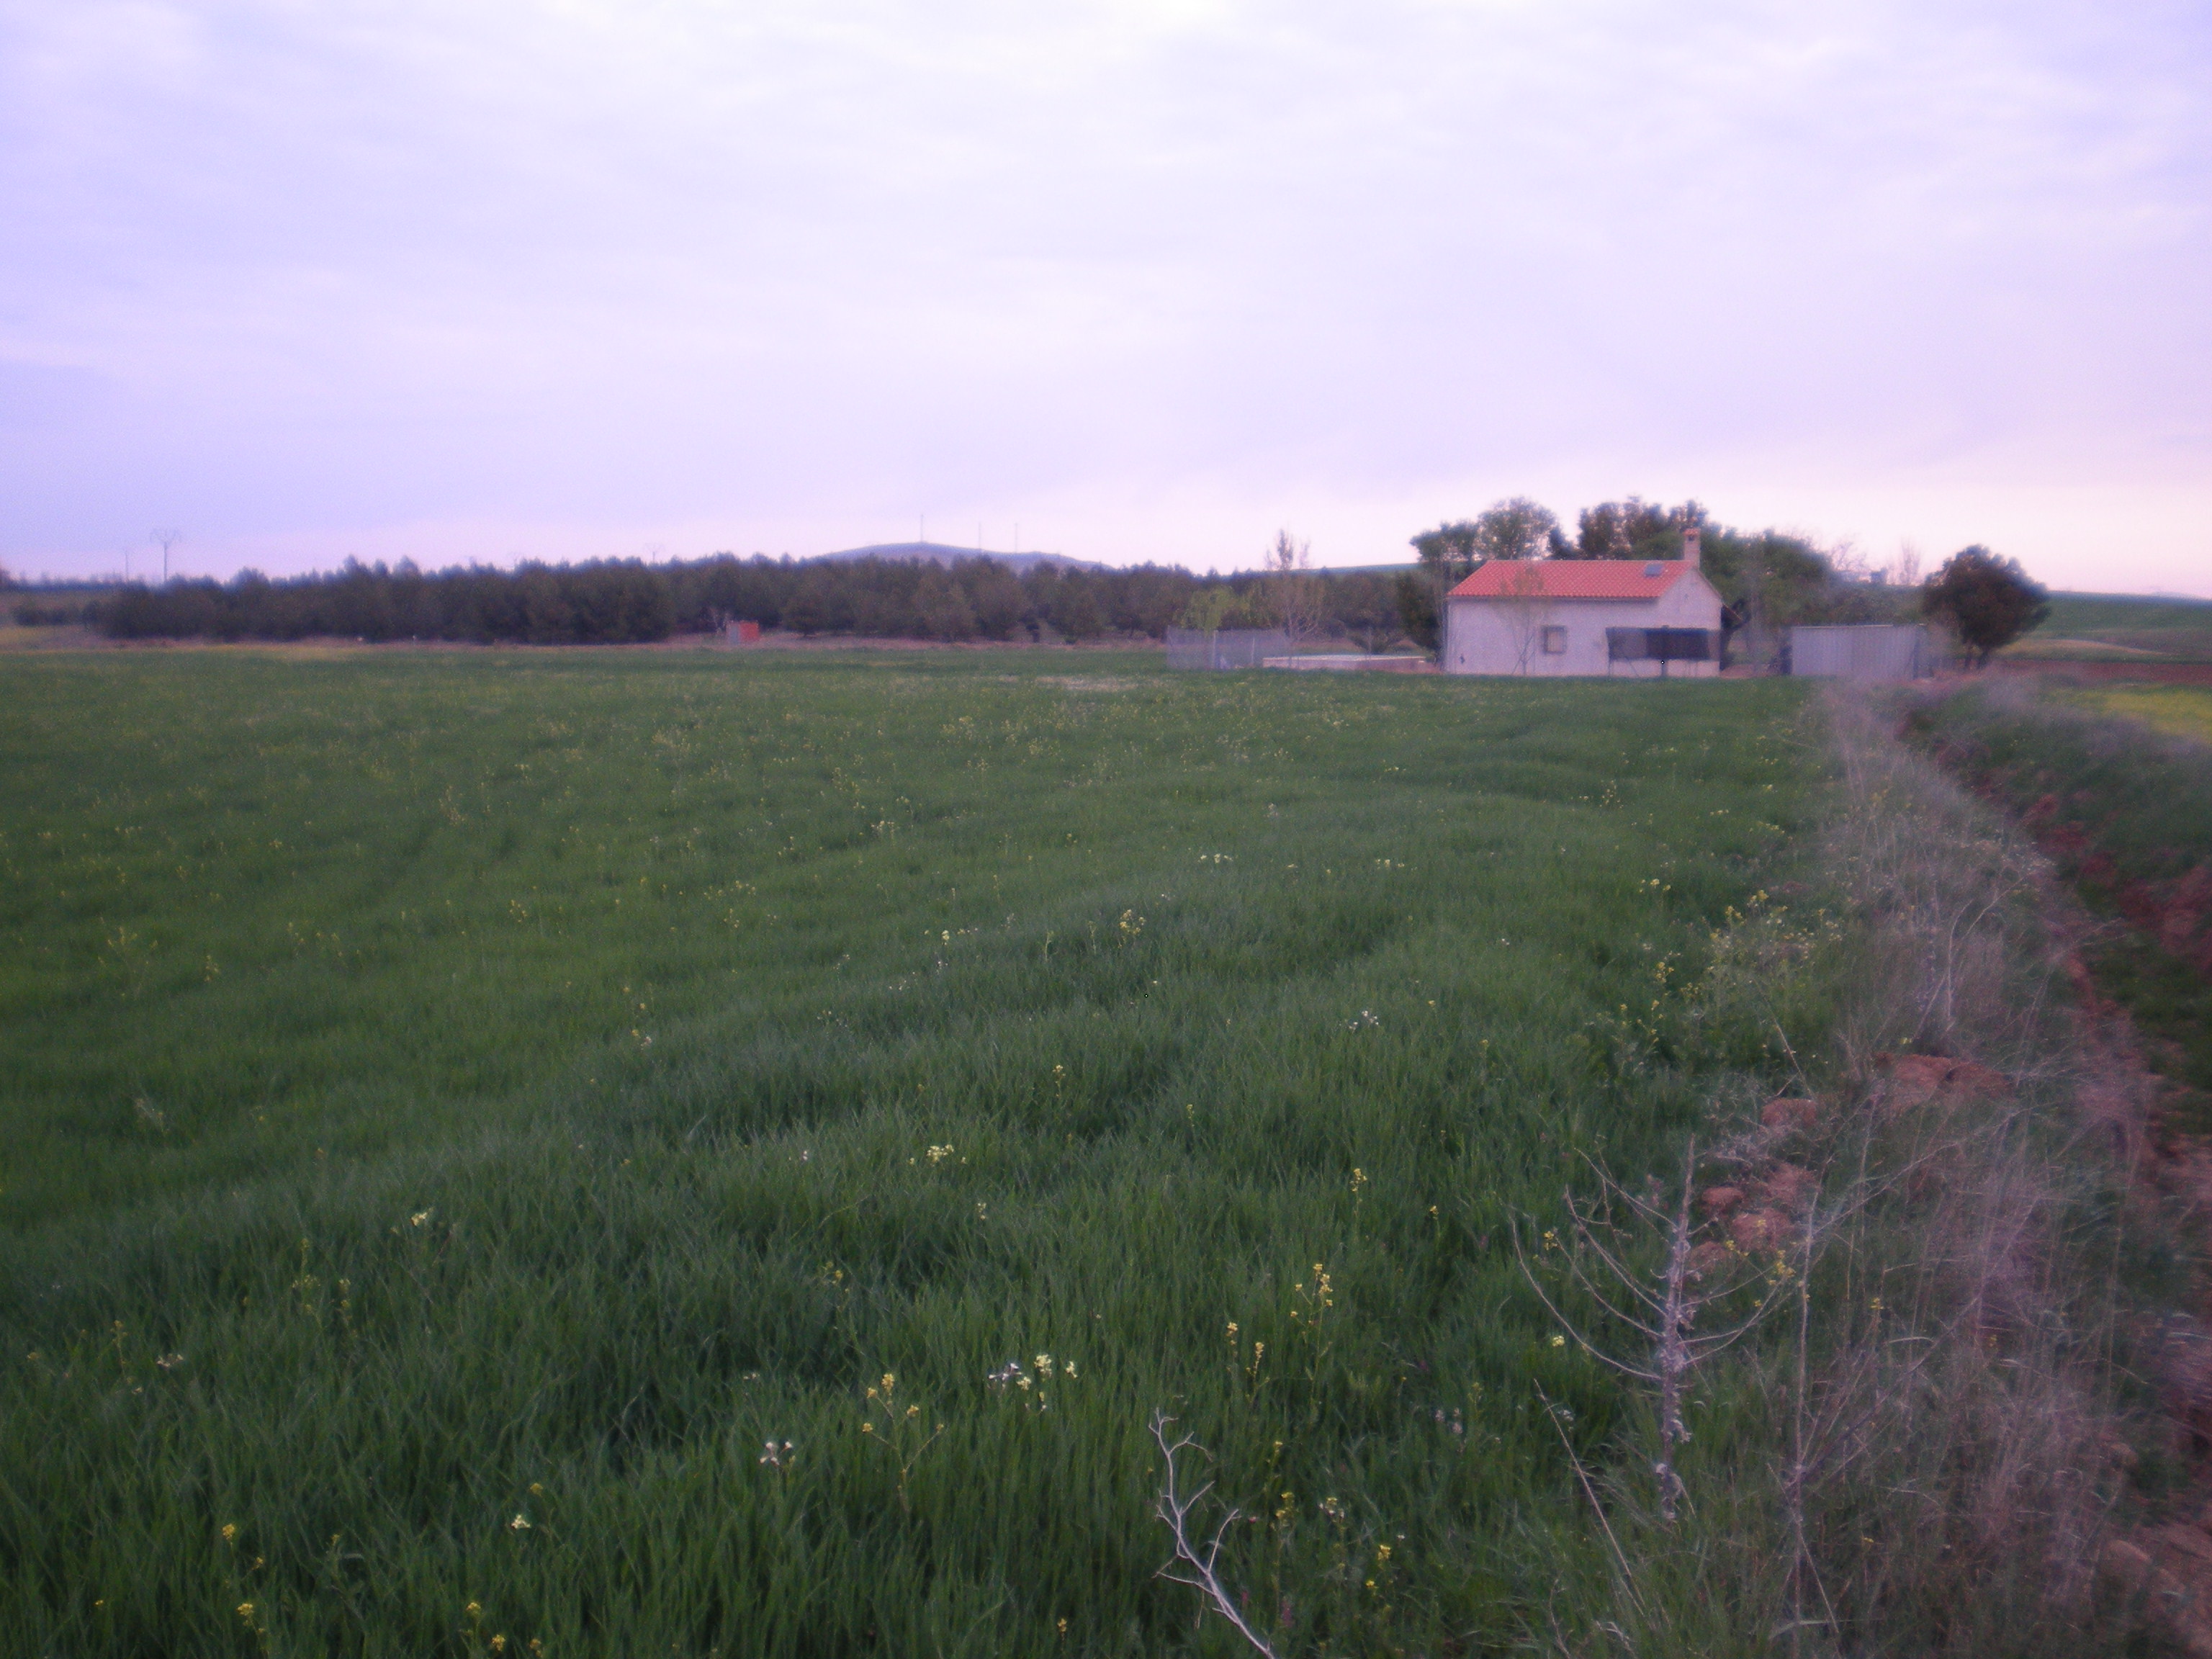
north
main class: Cropland
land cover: Oats
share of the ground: > 75 %
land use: Agriculture (excluding fallow land and kitchen gardens)
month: April
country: ES
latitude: 38.6206
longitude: -3.4594
